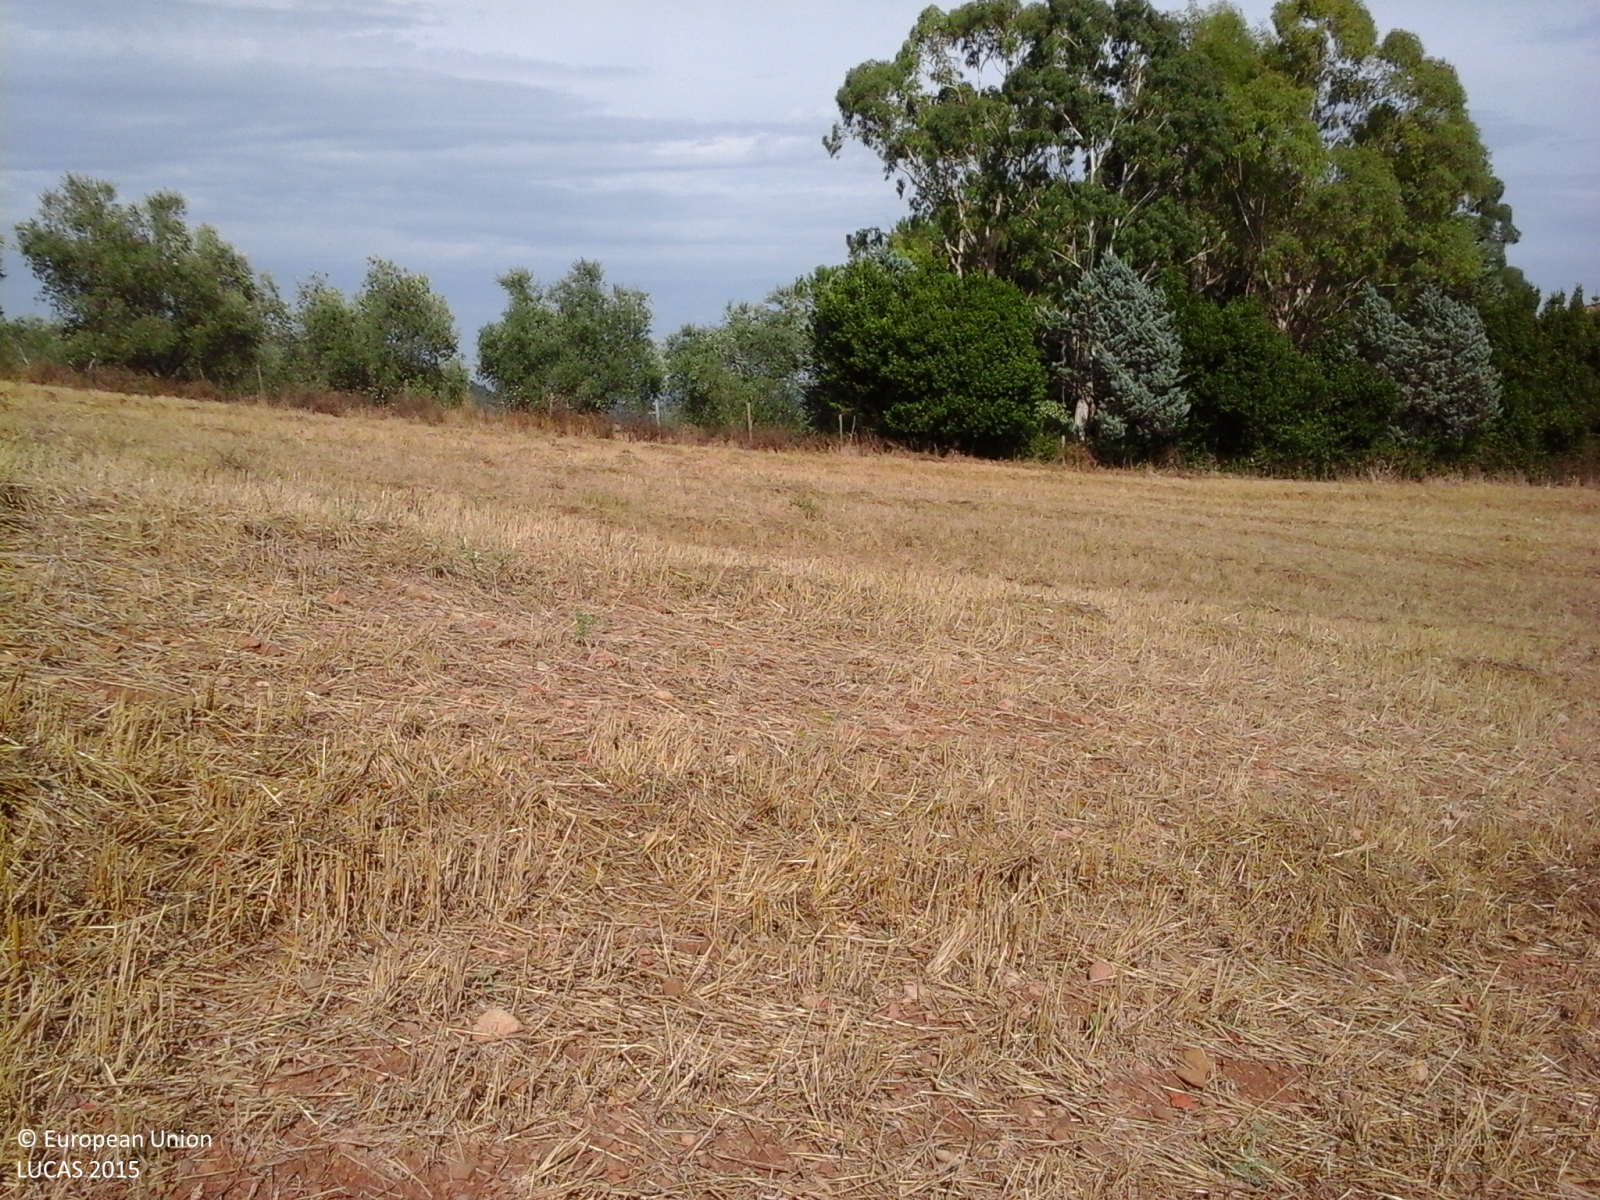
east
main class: Cropland
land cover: Barley
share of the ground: > 75 %
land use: Agriculture (excluding fallow land and kitchen gardens)
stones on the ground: 25 - 50 %
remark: Harvested field
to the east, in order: Barley; Fences; Grass margins; Lines of trees; Tracks; Lines of trees; Grass margins; Other leguminous and mixtures for fodder; Grass margins; Paved roads, cycling and walking lanes; Broadleaved woodland; Paved roads, cycling and walking lanes; Abandoned hedges; Other leguminous and mixtures for fodder; Fences; Abandoned hedges; Durum wheat
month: August
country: IT
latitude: 42.5697
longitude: 11.5662
